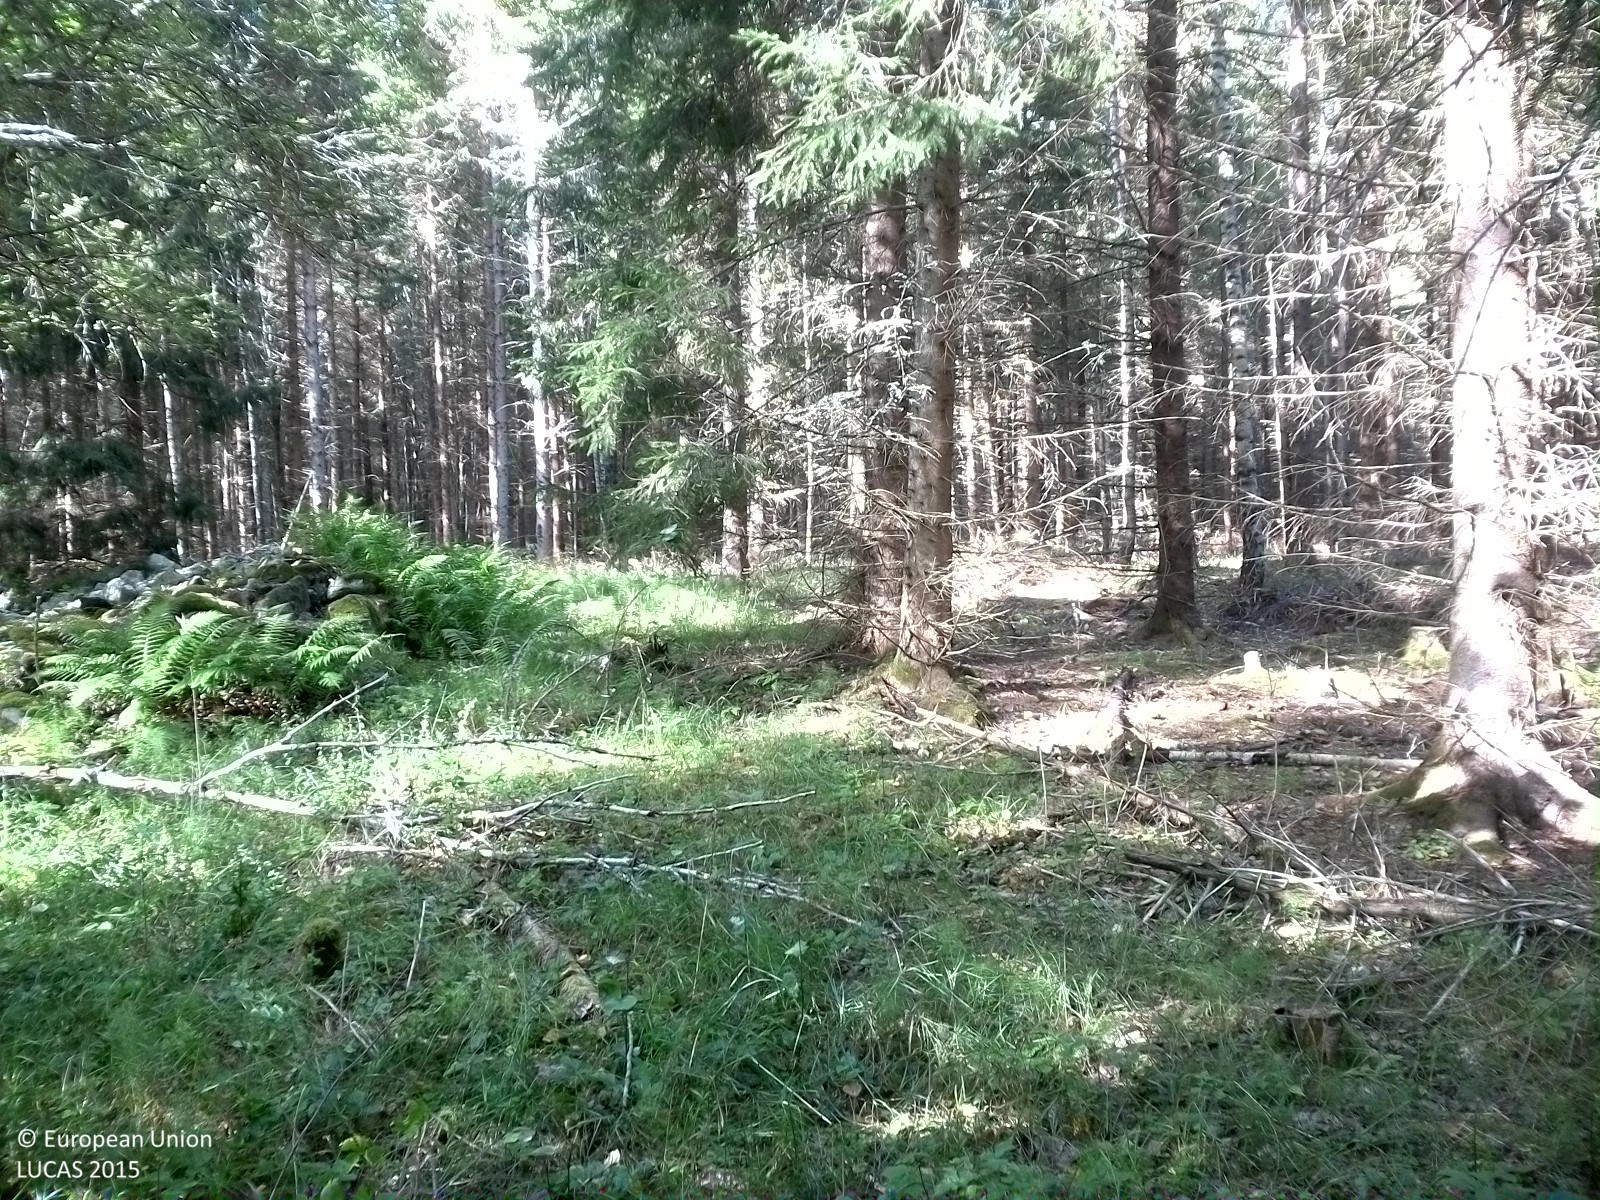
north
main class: Woodland
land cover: Spruce dominated mixed woodland
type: boreal forest
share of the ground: 25 - 50 %
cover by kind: herbaceous plants 35 %, coniferous forest trees 30 %, broadleaved forest trees 15 %, lichens and mosses 10 %, unconsolidated bare surface 10 %
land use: Forestry
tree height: > 5 m
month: August
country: SE
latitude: 59.0814
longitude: 15.4887
